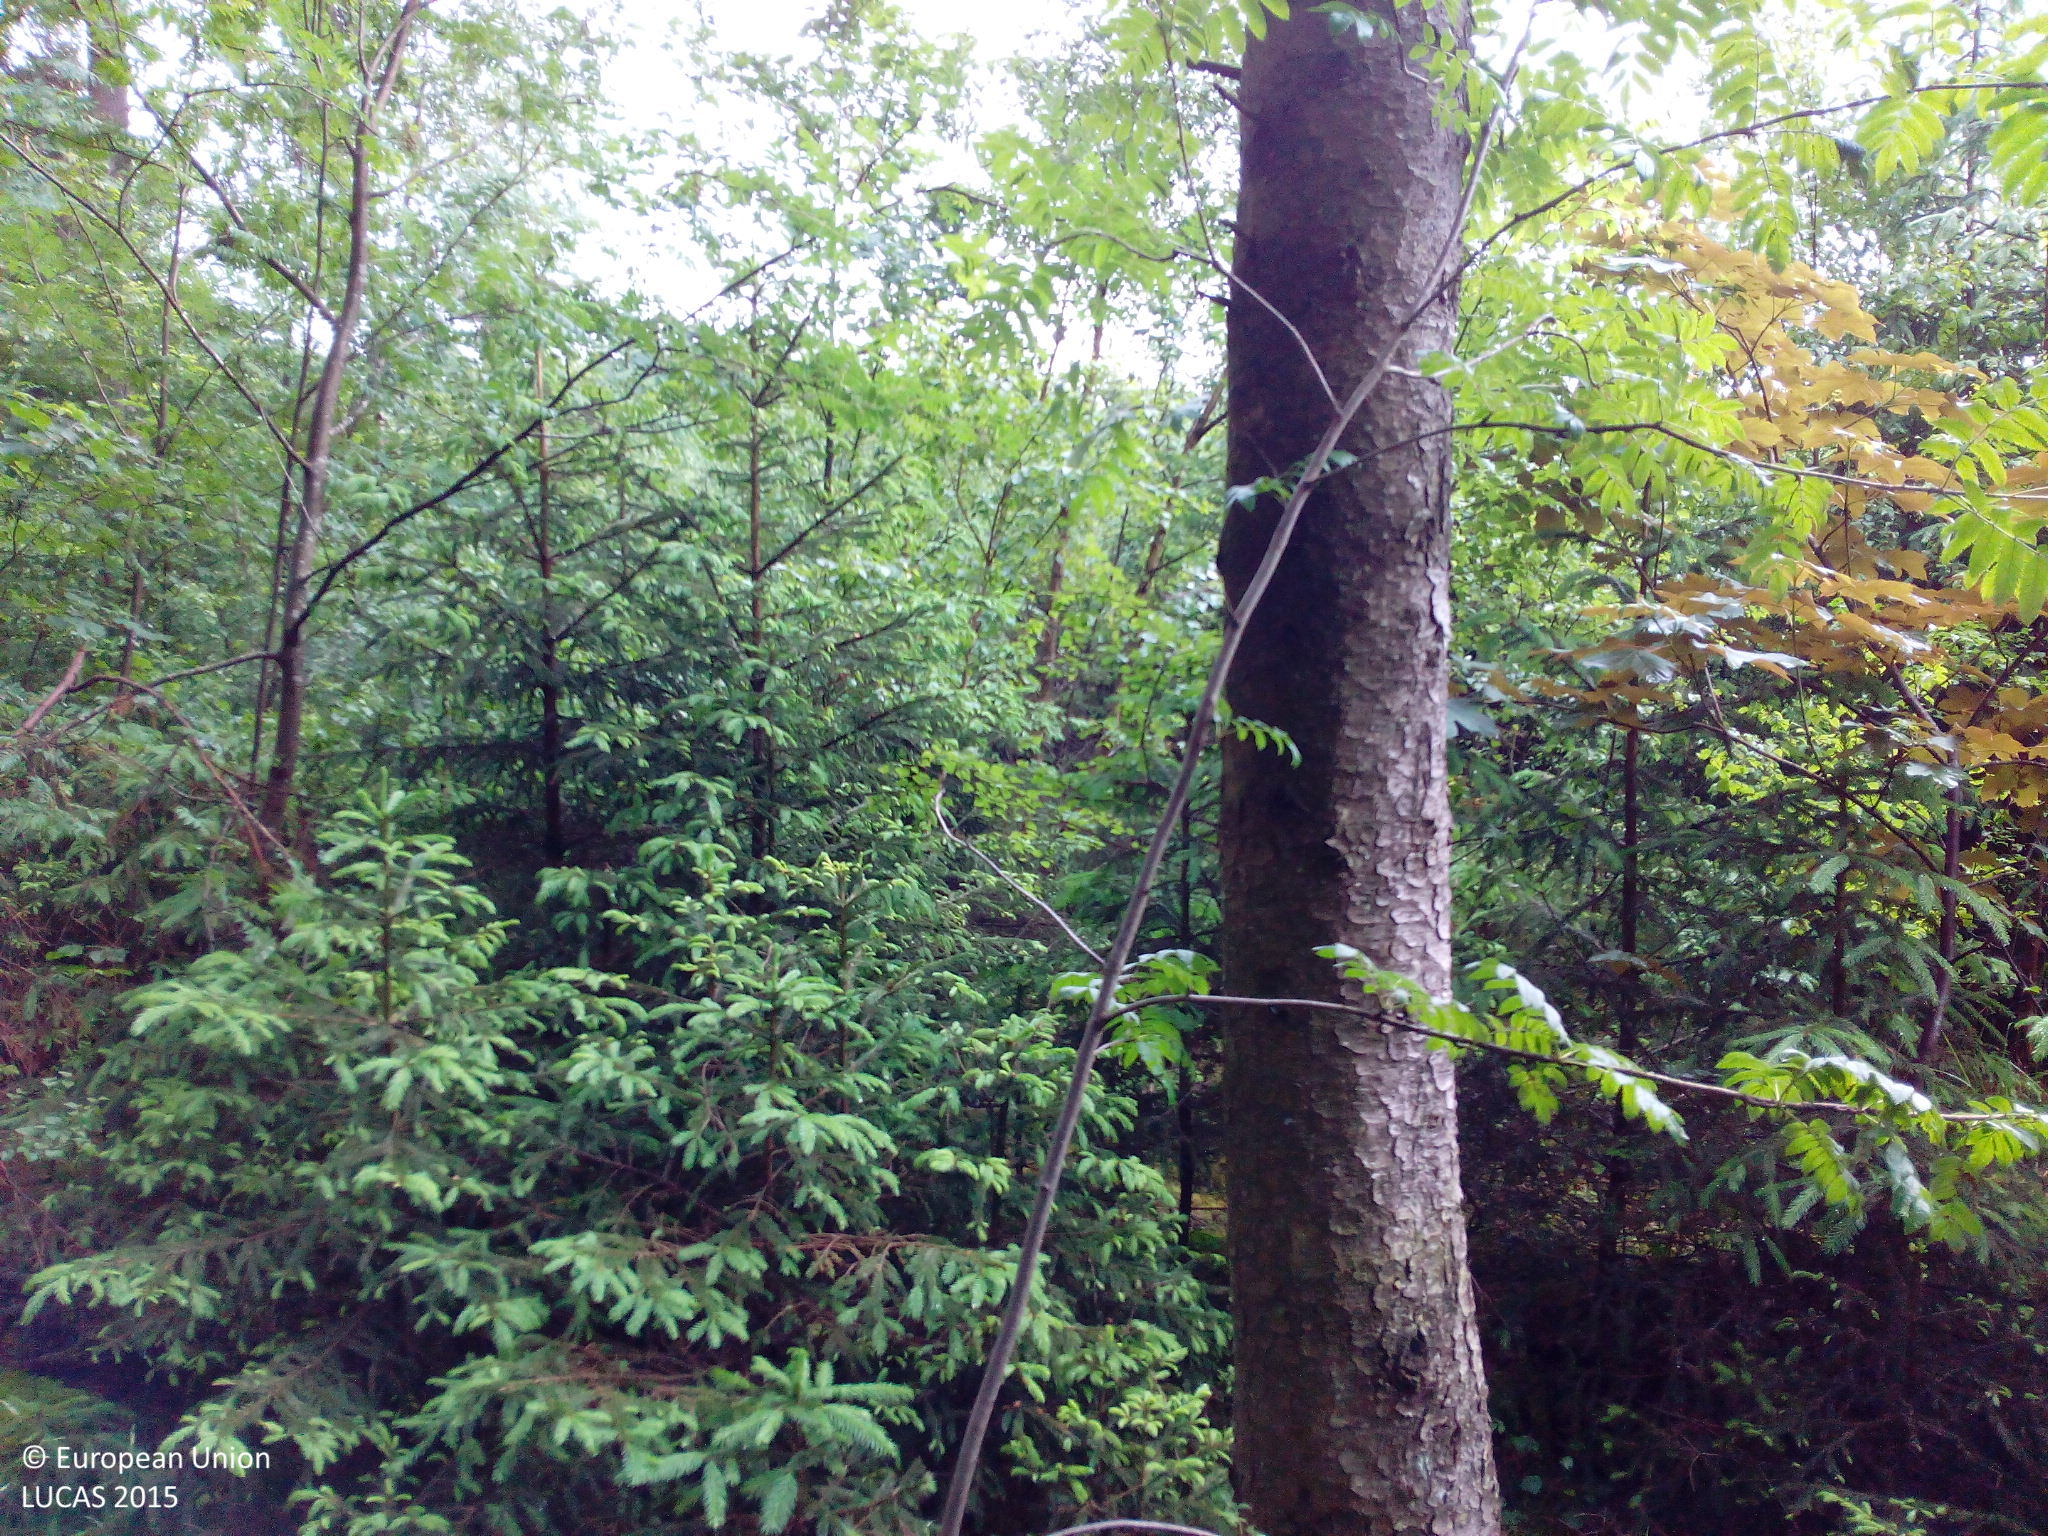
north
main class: Woodland
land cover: Spruce dominated coniferous woodland
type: hemiboreal forest and nemoral coniferous forest and mixed broadleaved-coniferous forest
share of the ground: > 75 %
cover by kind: coniferous forest trees 95 %, broadleaved forest trees 5 %
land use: Forestry
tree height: > 5 m
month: June
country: DE
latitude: 48.0892
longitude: 11.3552
